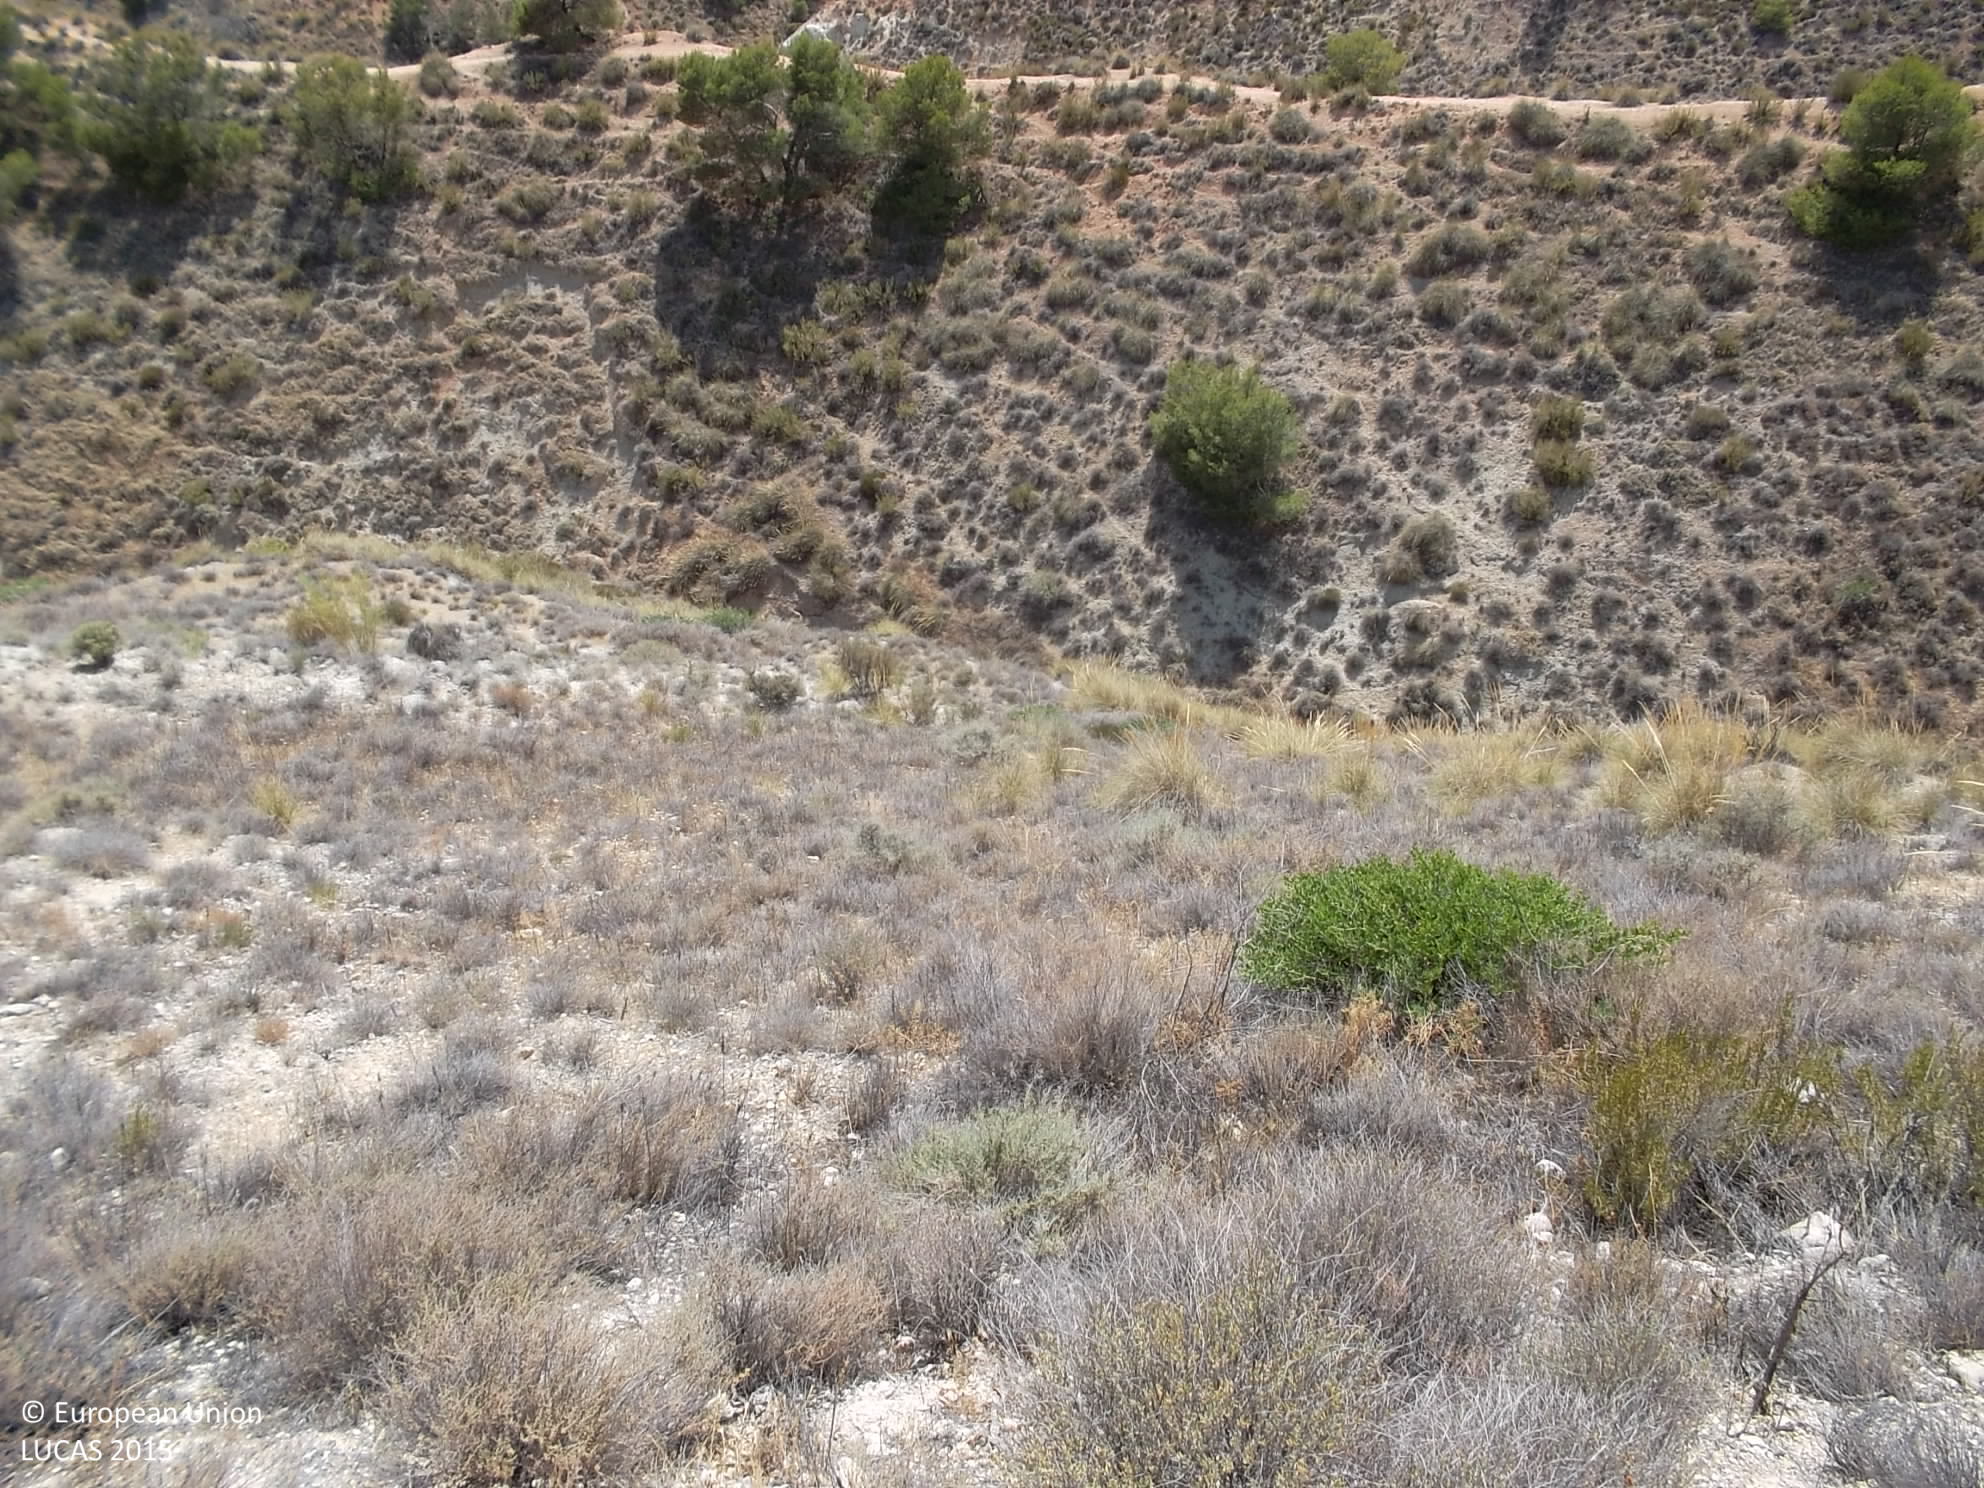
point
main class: Grassland
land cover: Grassland with sparse tree/shrub cover
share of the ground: > 75 %
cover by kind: herbaceous plants 85 %, shrubs 10 %, broadleaved forest trees 5 %
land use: Semi-natural and natural areas not in use
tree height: < 5 m
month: June
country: ES
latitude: 37.6490
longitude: -3.1972
